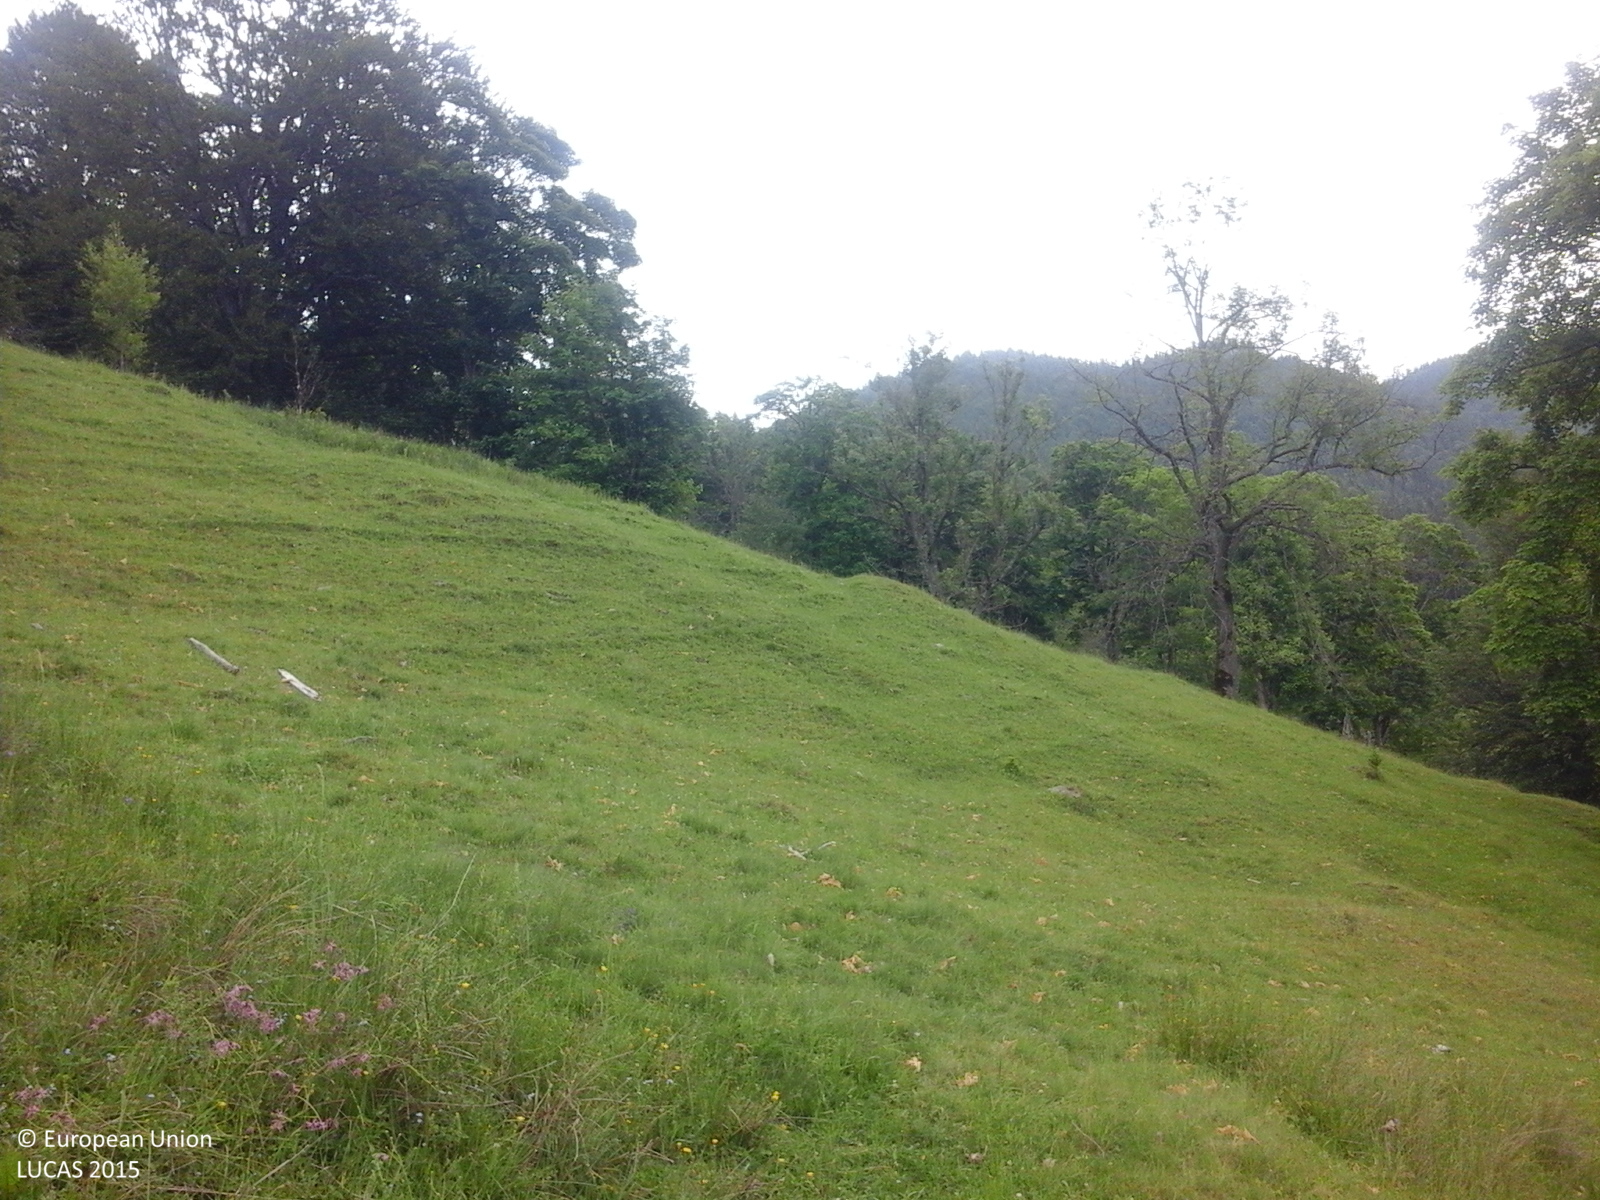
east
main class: Grassland
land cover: Grassland without tree/shrub cover
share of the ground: > 75 %
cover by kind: herbaceous plants 100 %
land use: Agriculture (excluding fallow land and kitchen gardens)
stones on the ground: 10 - 25 %
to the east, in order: Grassland without tree/shrub cover; Grassland with sparse tree/shrub cover; Grassland without tree/shrub cover
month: June
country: RO
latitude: 47.3323
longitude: 25.6681
